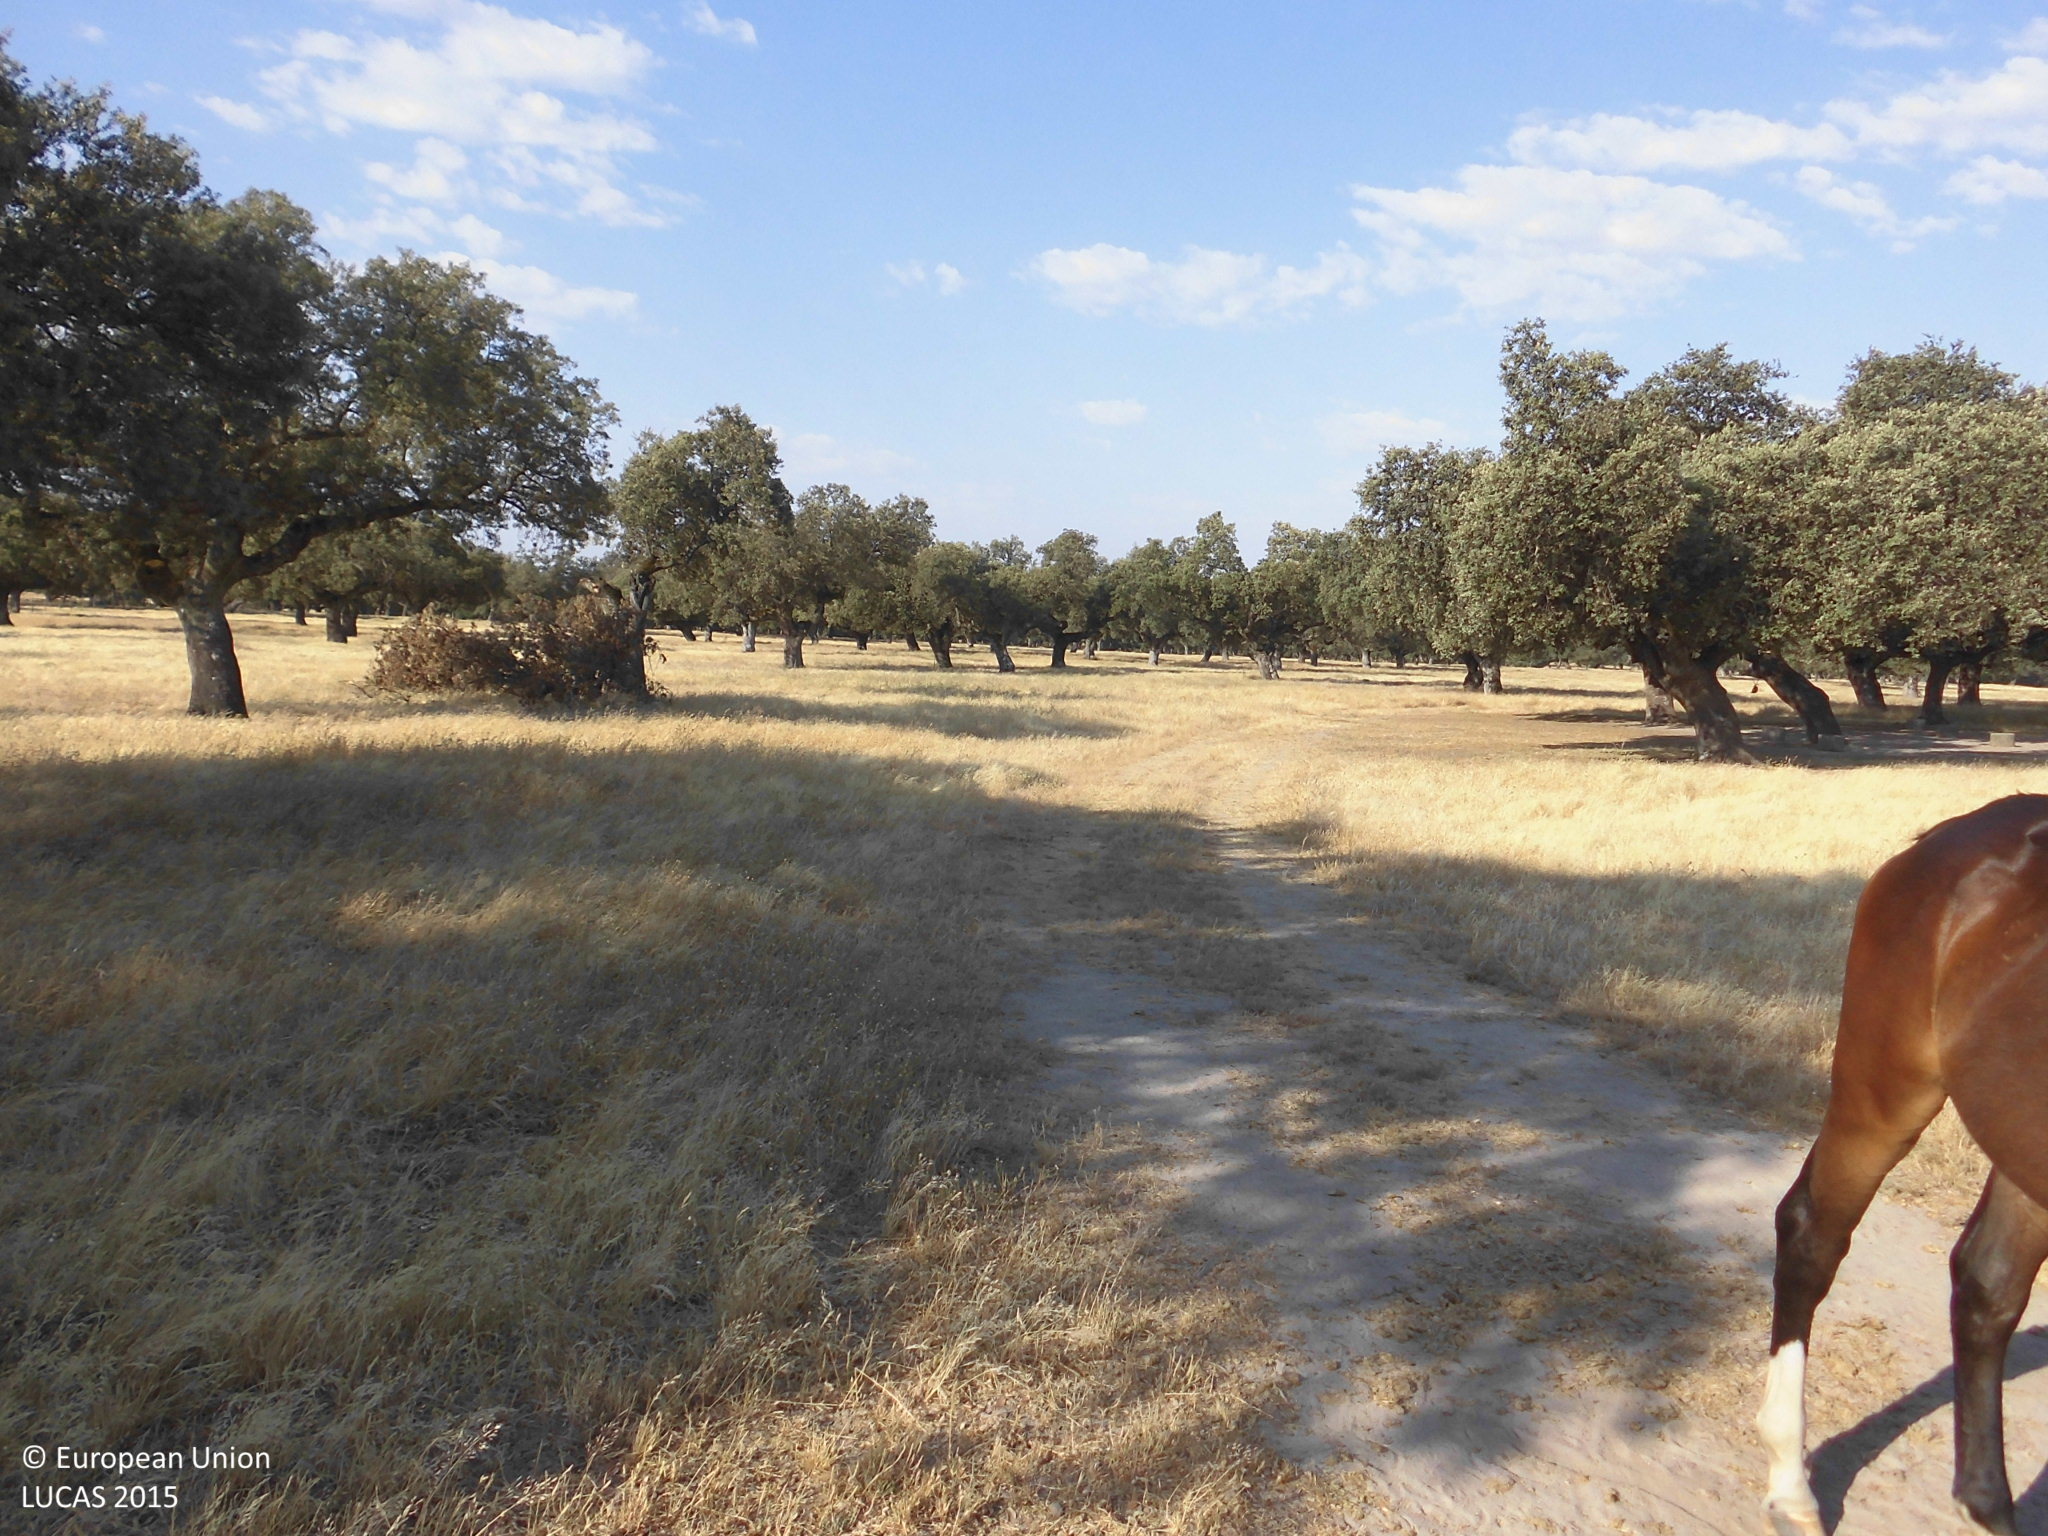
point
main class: Woodland
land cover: Broadleaved woodland
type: broadleaved evergreen forest
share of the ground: 25 - 50 %
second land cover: Grassland without tree/shrub cover
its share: > 75 %
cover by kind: herbaceous plants 70 %, broadleaved forest trees 30 %
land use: Forestry
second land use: Agriculture (excluding fallow land and kitchen gardens)
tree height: > 5 m
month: June
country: ES
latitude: 39.9578
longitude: -5.4279
